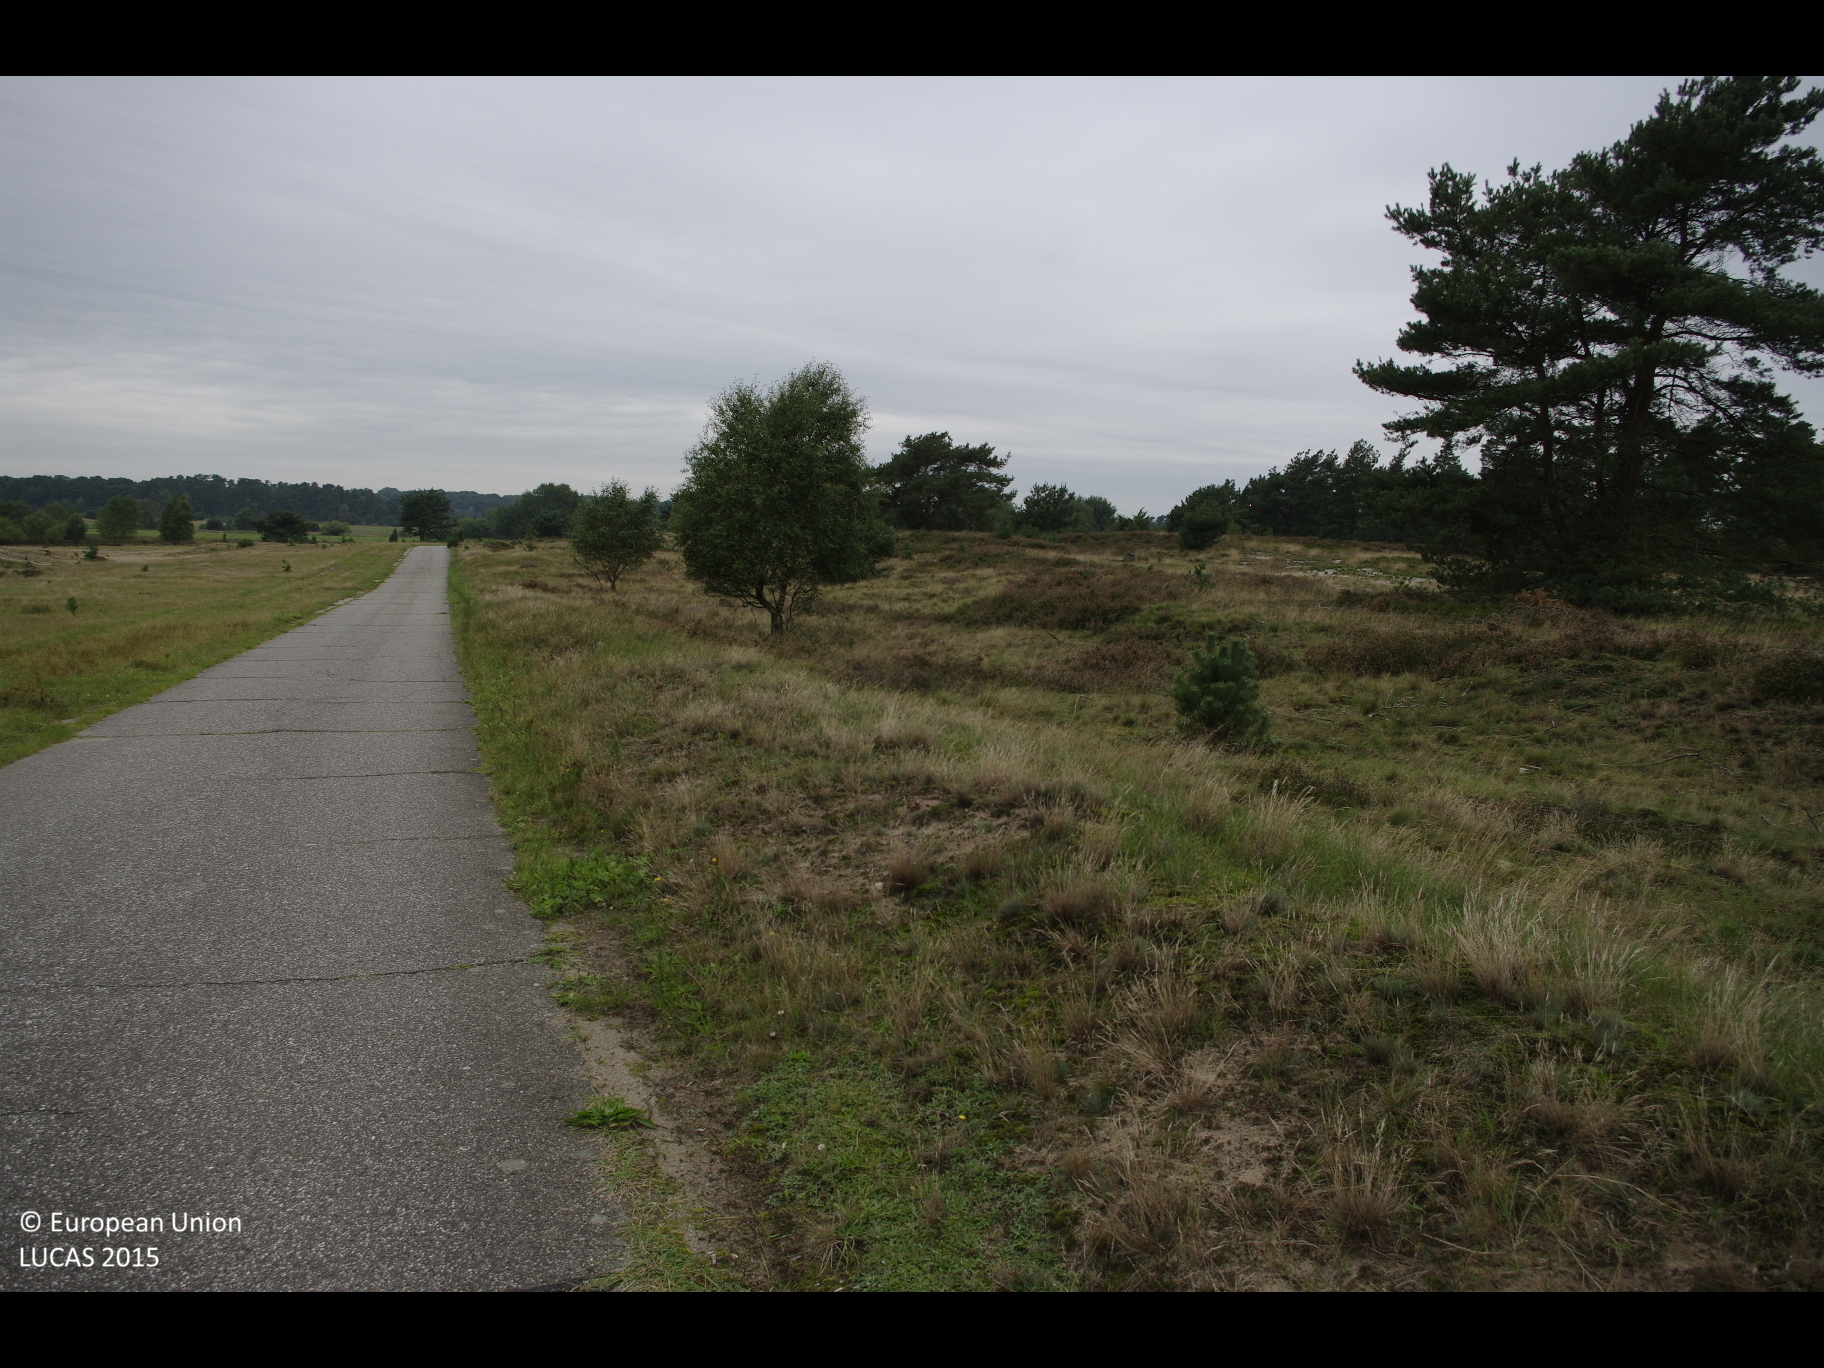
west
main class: Woodland
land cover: Pine dominated coniferous woodland
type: hemiboreal forest and nemoral coniferous forest and mixed broadleaved-coniferous forest
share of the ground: 50 - 75 %
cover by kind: coniferous forest trees 60 %, shrubs 40 %
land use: Forestry
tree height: > 5 m
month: September
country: DE
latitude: 53.1323
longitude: 9.9253
